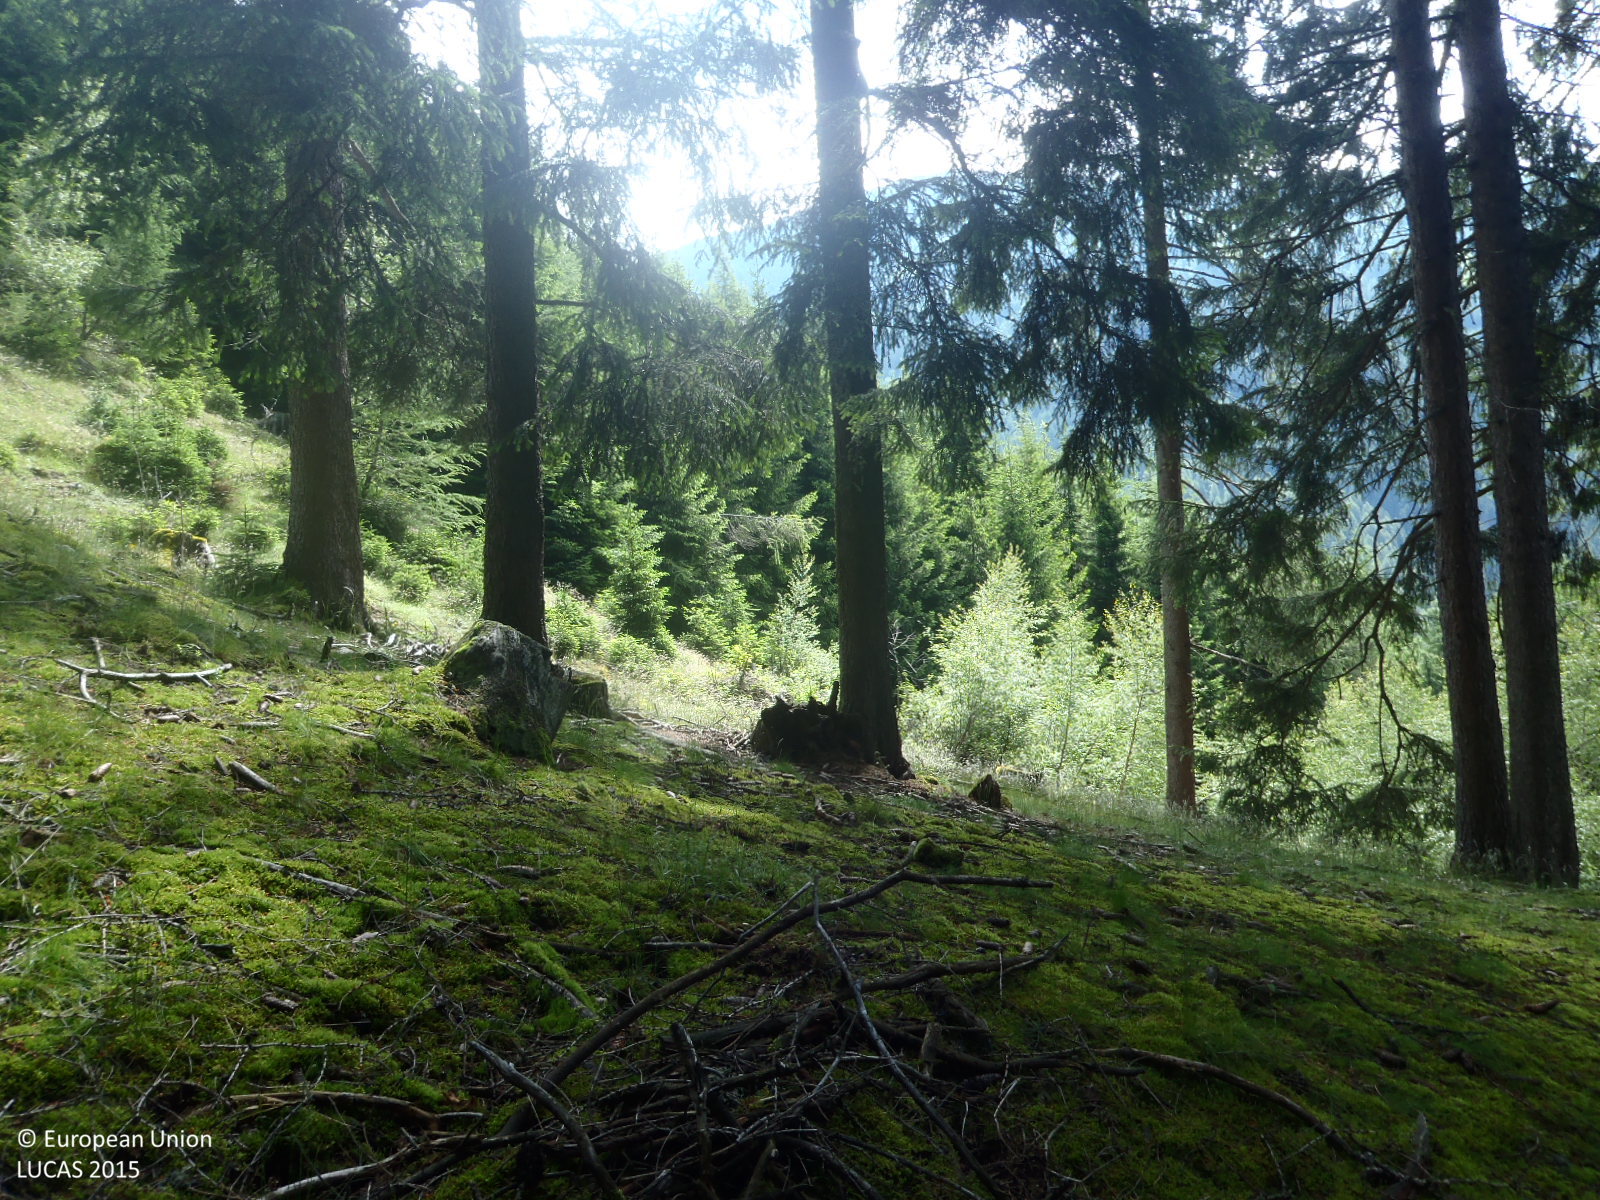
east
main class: Woodland
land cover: Spruce dominated coniferous woodland
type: alpine coniferous forest
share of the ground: > 75 %
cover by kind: coniferous forest trees 90 %, herbaceous plants 5 %, lichens and mosses 5 %
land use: Forestry
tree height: > 5 m
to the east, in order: Spruce dominated coniferous woodland; Spruce dominated mixed woodland; Spruce dominated coniferous woodland; Fences; Grassland without tree/shrub cover
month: June
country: AT
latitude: 47.1697
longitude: 11.4630
